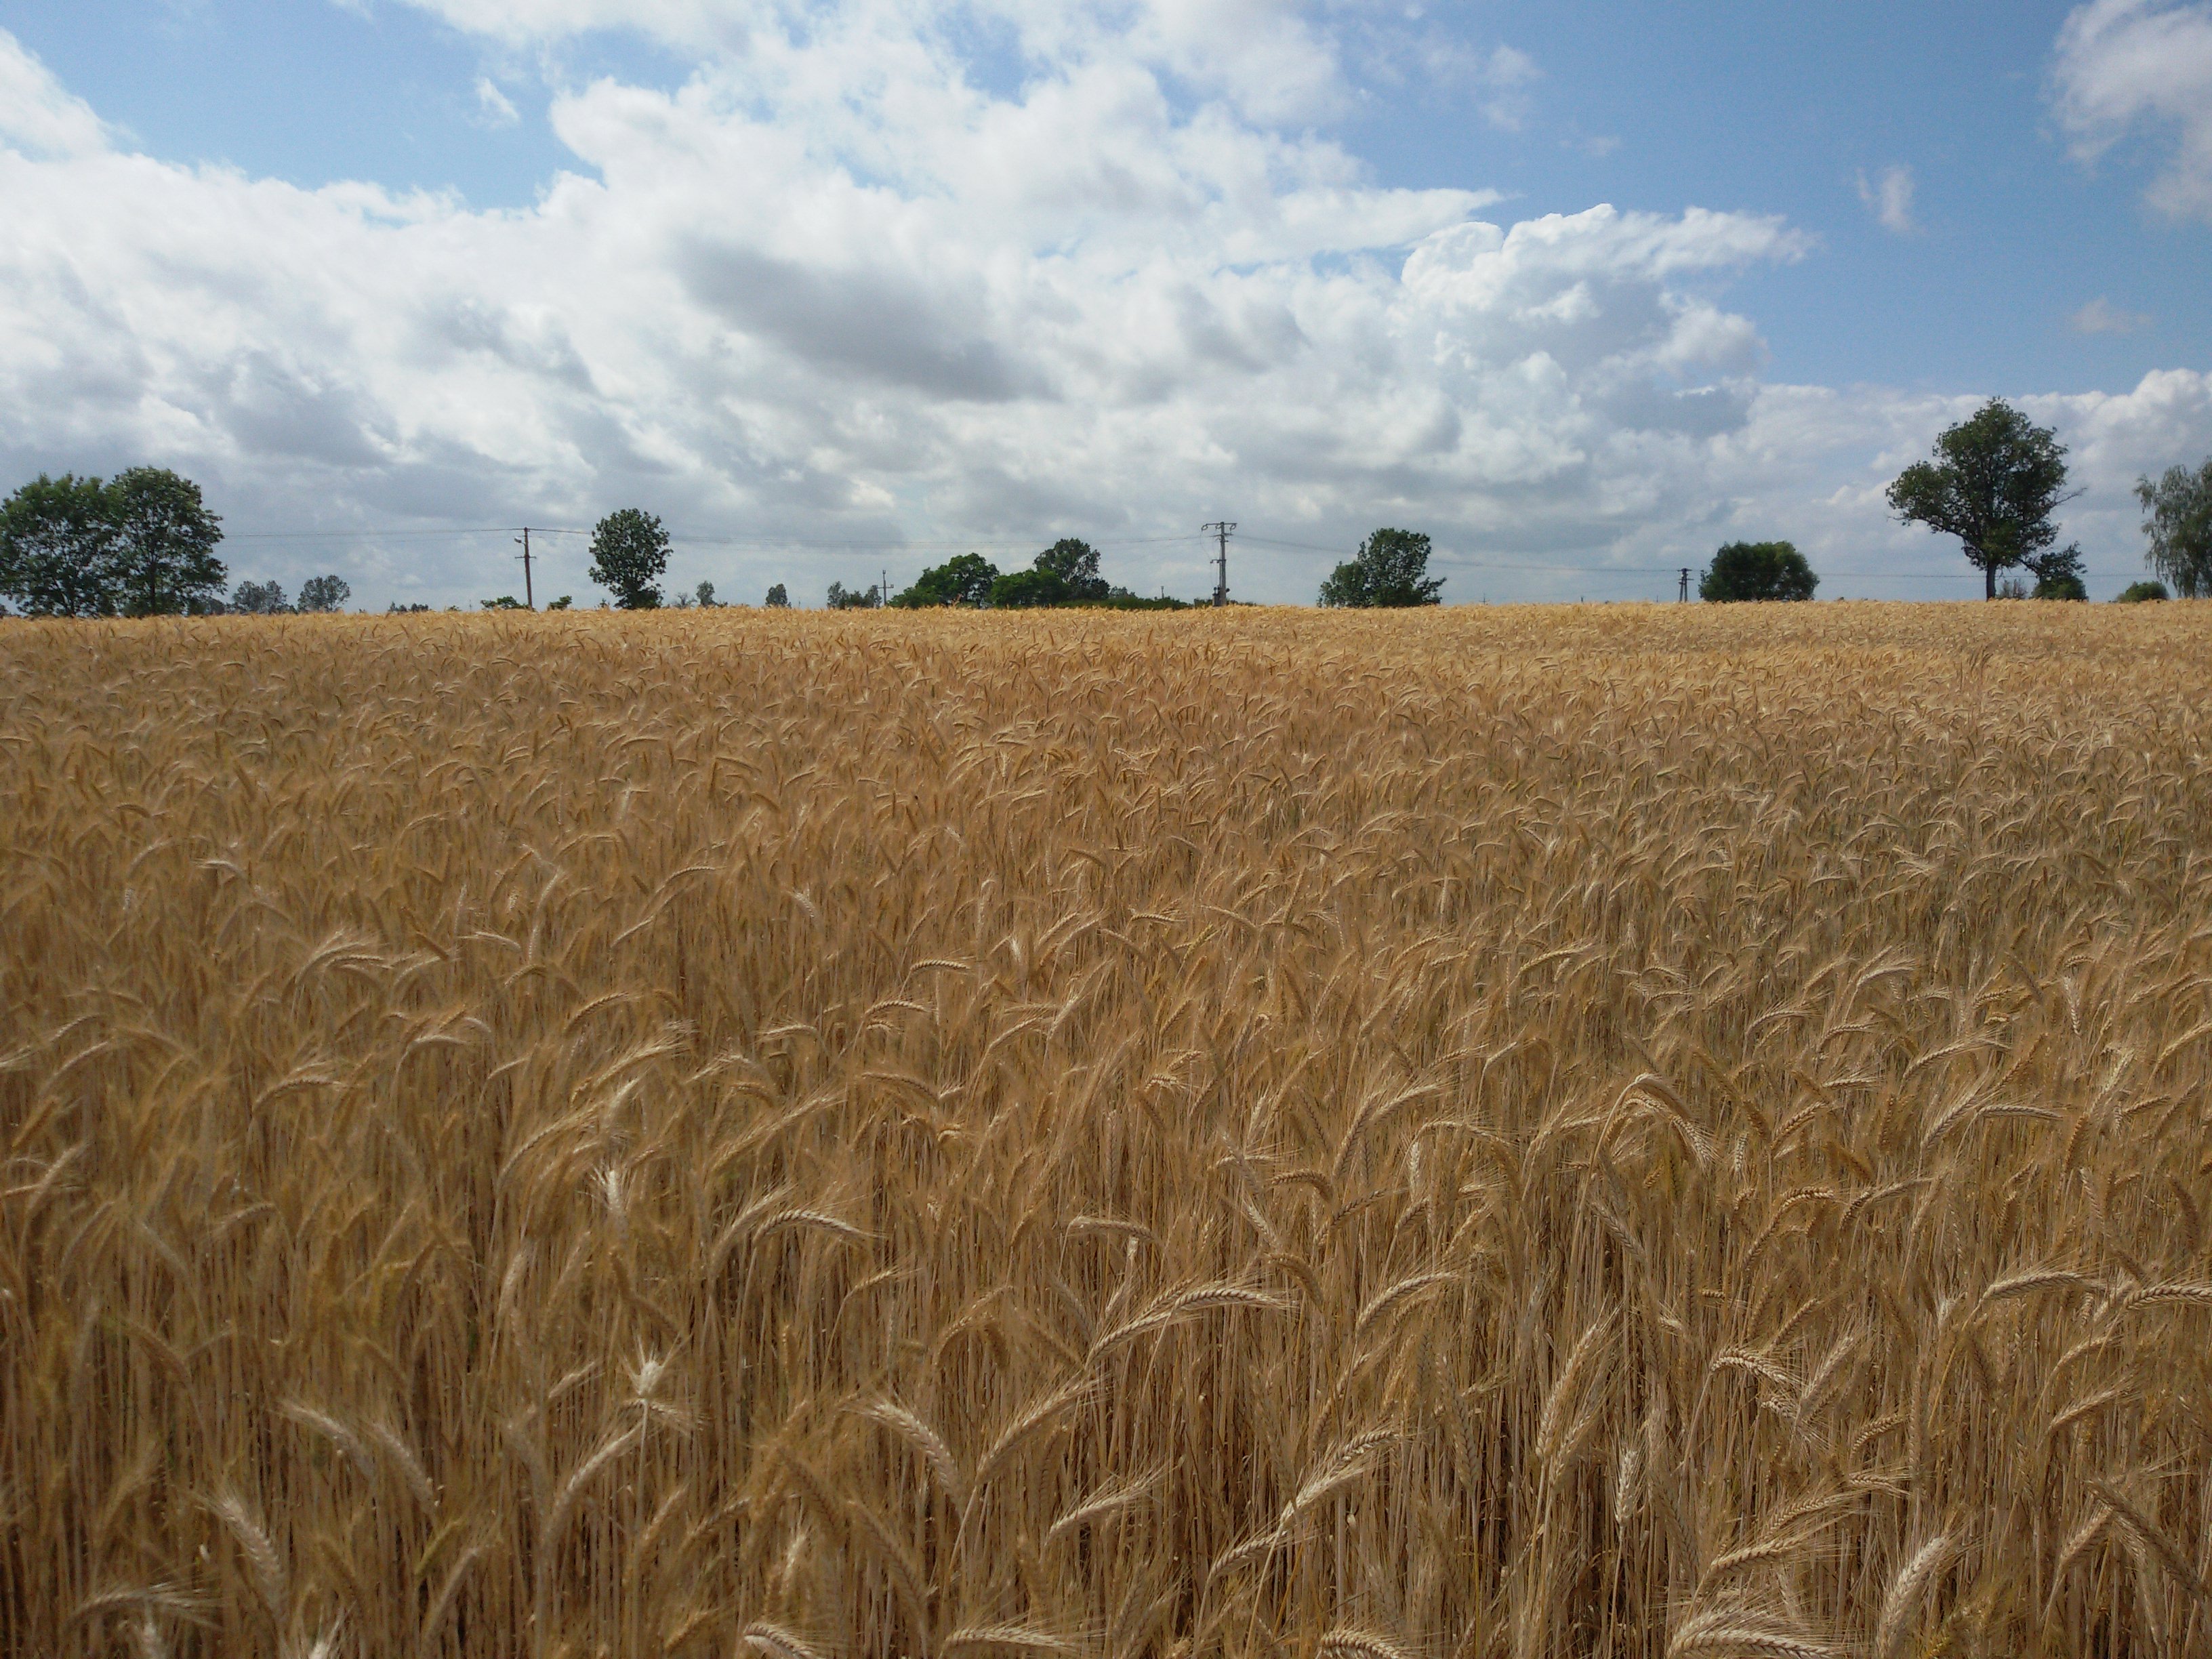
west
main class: Cropland
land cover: Triticale
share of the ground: > 75 %
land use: Agriculture (excluding fallow land and kitchen gardens)
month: July
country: PL
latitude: 52.8004
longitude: 17.6219
